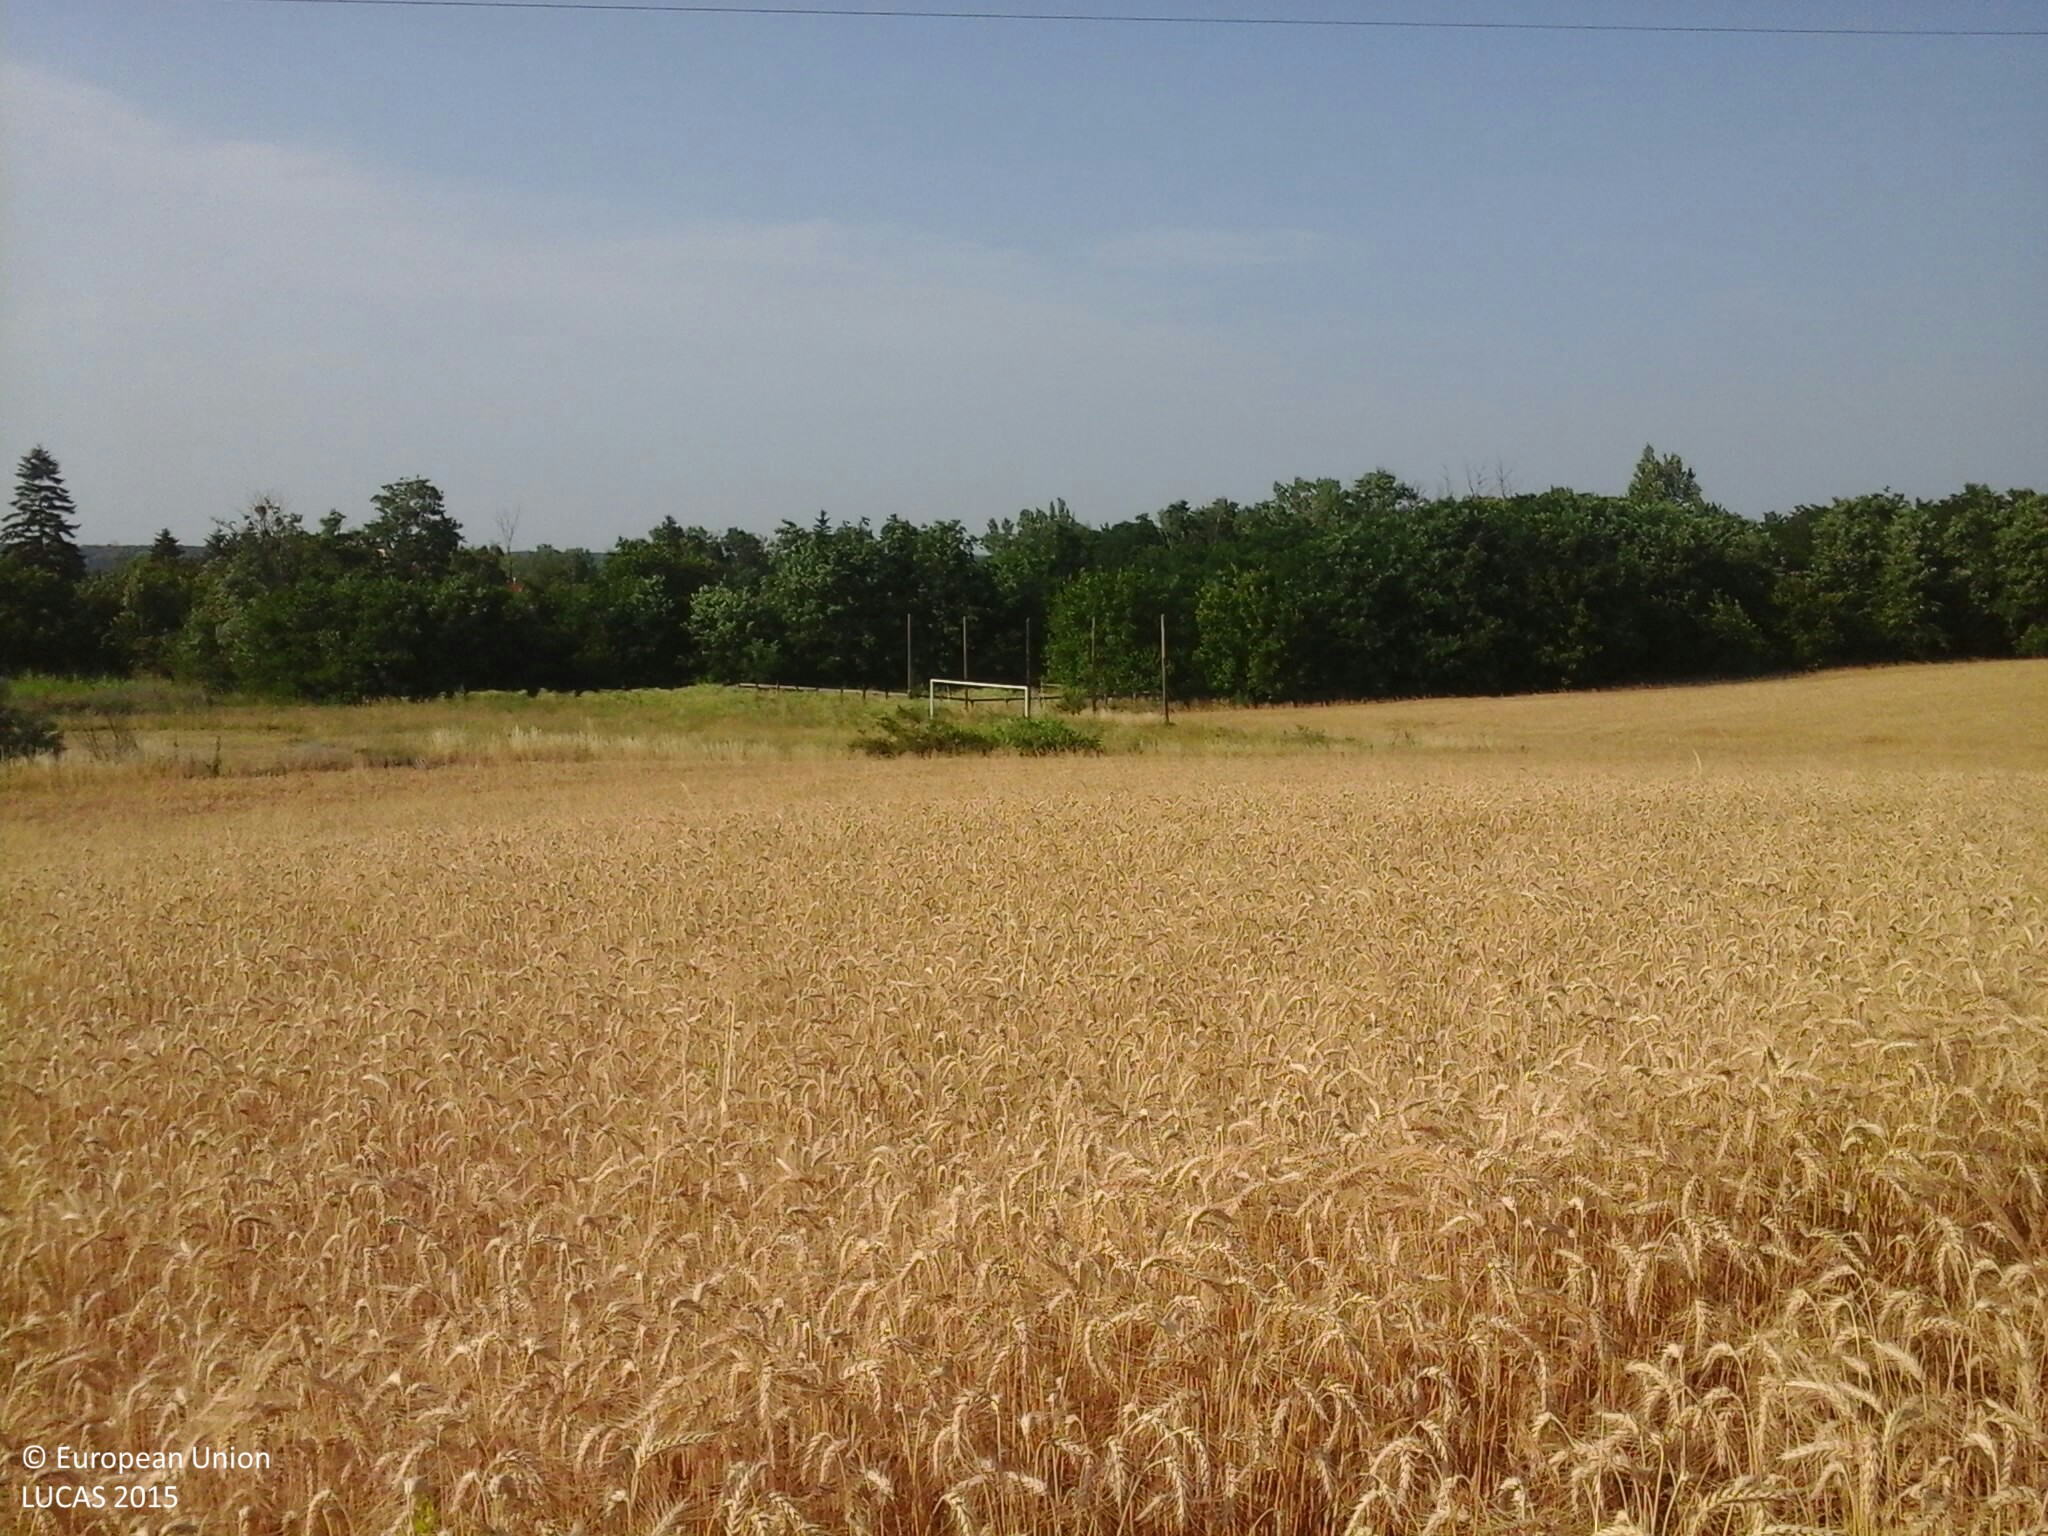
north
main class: Cropland
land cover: Common wheat
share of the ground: > 75 %
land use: Agriculture (excluding fallow land and kitchen gardens)
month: July
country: HU
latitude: 47.1628
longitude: 17.3803
